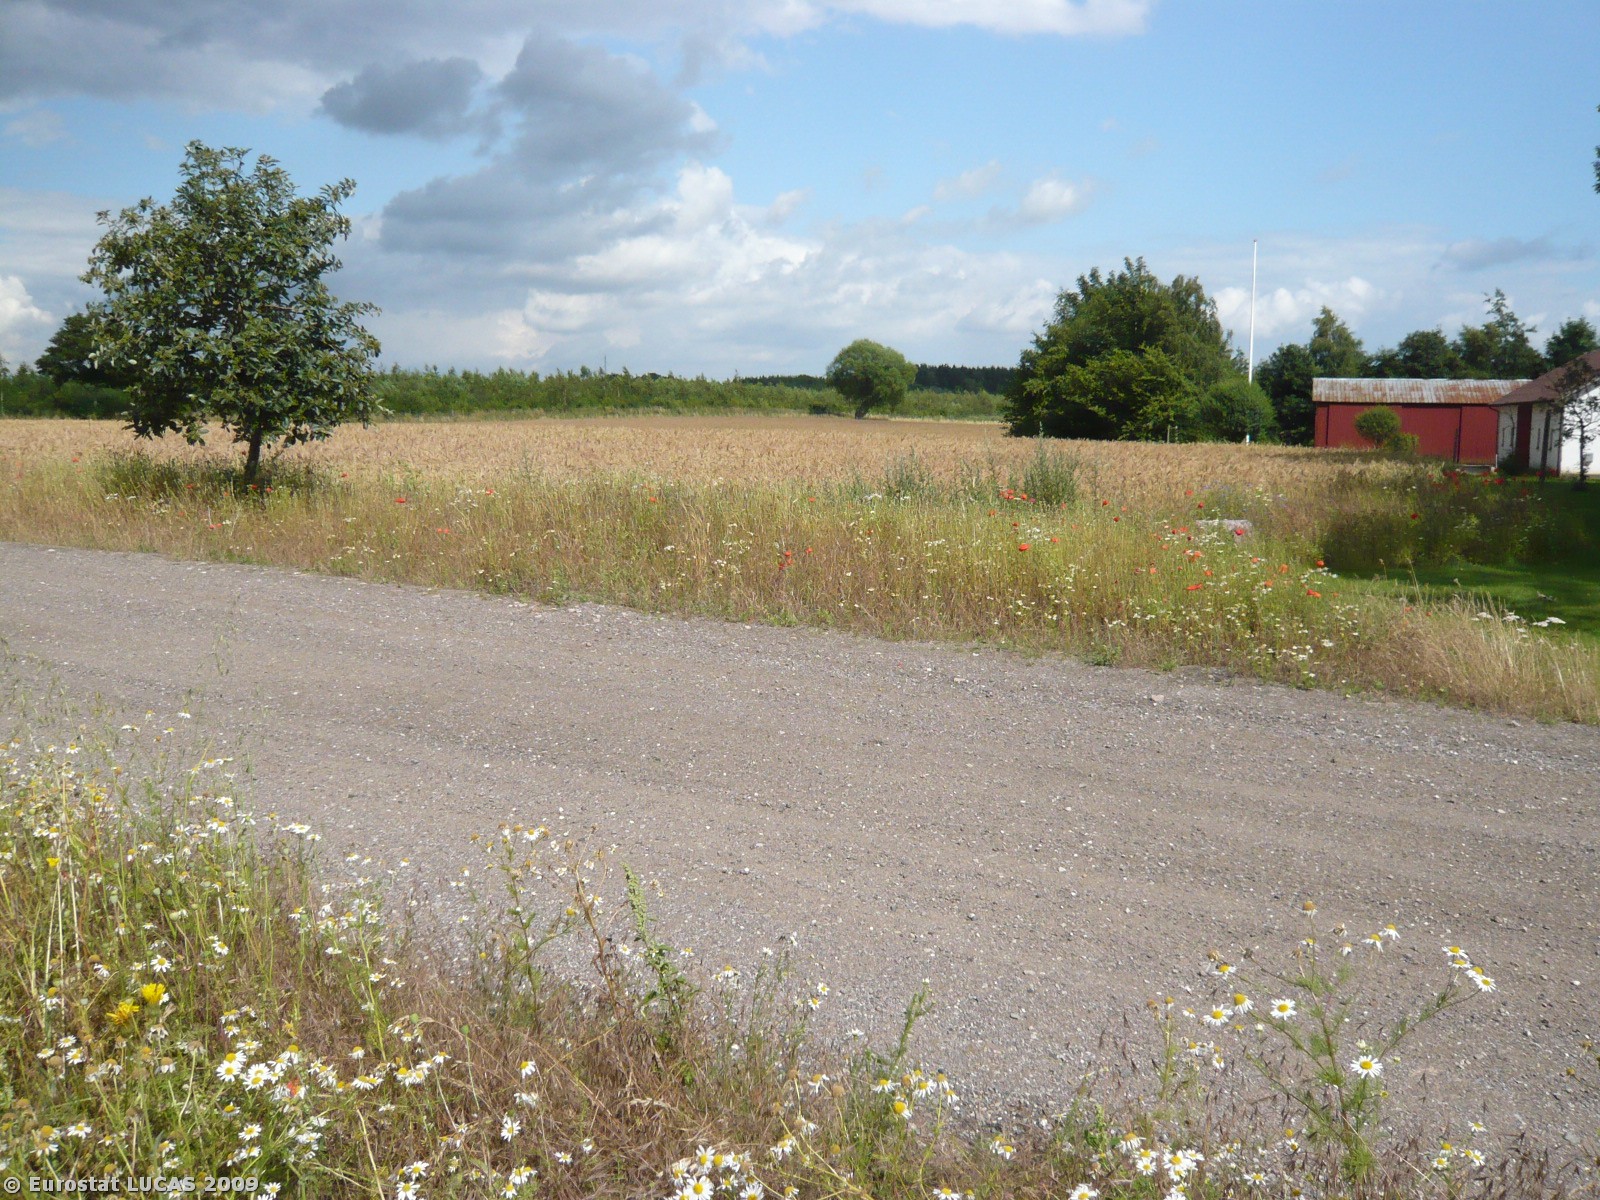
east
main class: Cropland
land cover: Barley
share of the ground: > 75 %
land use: Agriculture (excluding fallow land and kitchen gardens)
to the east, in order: Barley; Lines of trees; Tracks; Lines of trees; Barley; Grass margins; Paved roads, cycling and walking lanes; Fences; Grassland without tree/shrub cover; Shrubland with sparse tree cover
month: July
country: DK
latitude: 55.5306
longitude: 11.5987
